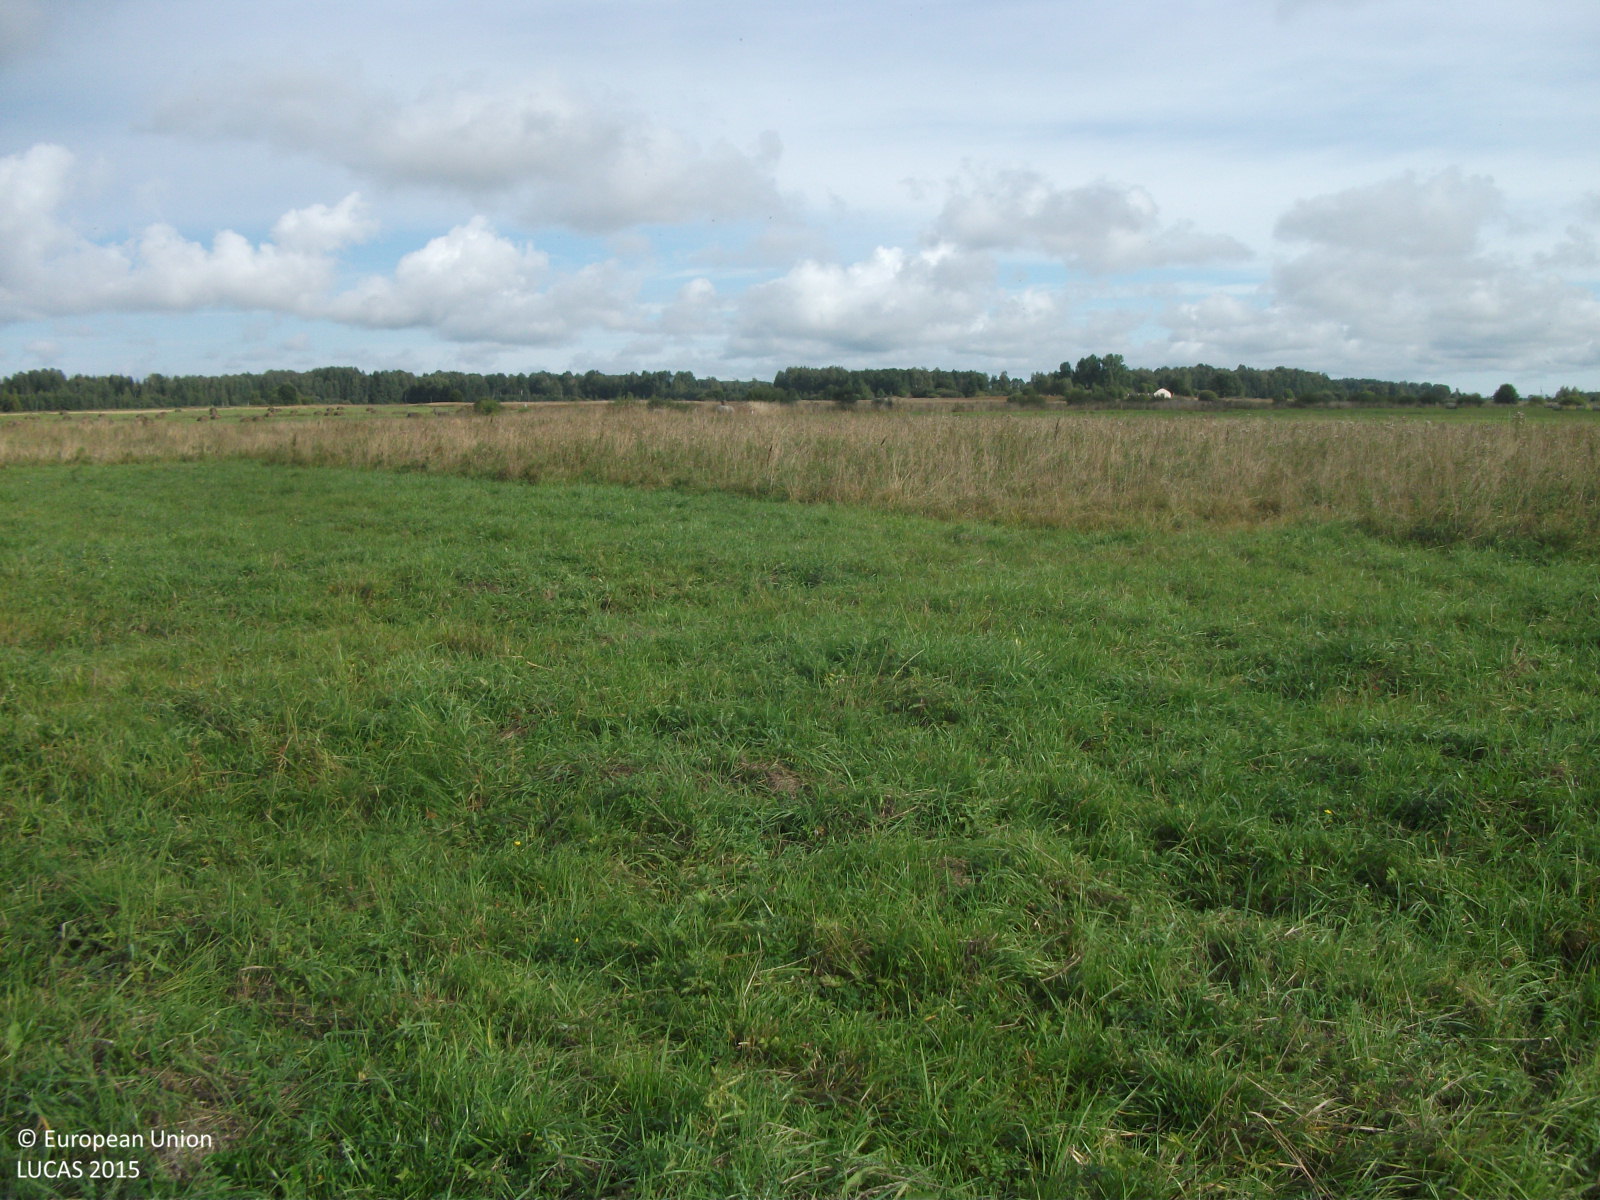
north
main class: Grassland
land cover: Grassland without tree/shrub cover
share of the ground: > 75 %
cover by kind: herbaceous plants 100 %
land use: Agriculture (excluding fallow land and kitchen gardens)
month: September
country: LV
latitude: 56.5425
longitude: 26.2243
